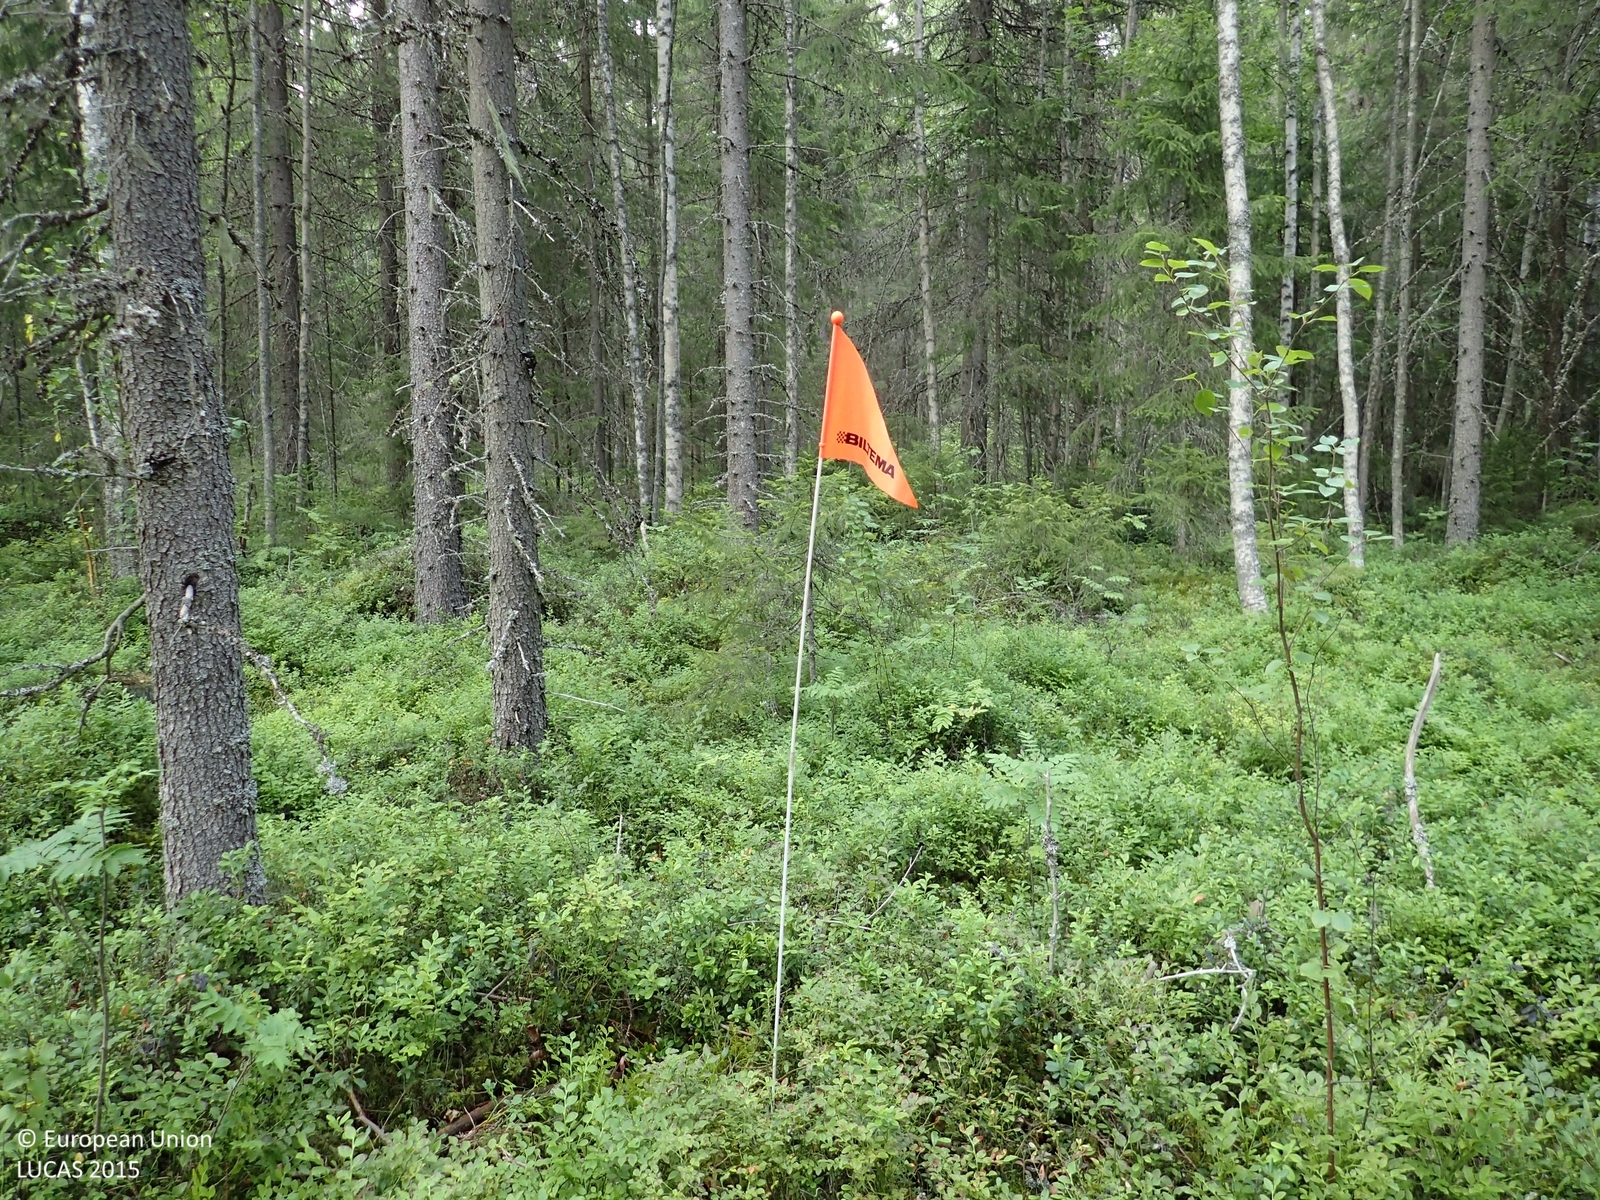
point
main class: Woodland
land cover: Spruce dominated coniferous woodland
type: boreal forest
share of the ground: > 75 %
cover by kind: coniferous forest trees 65 %, shrubs 20 %, broadleaved forest trees 10 %, lichens and mosses 5 %
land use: Forestry
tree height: > 5 m
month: August
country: FI
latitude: 62.7574
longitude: 21.9323
